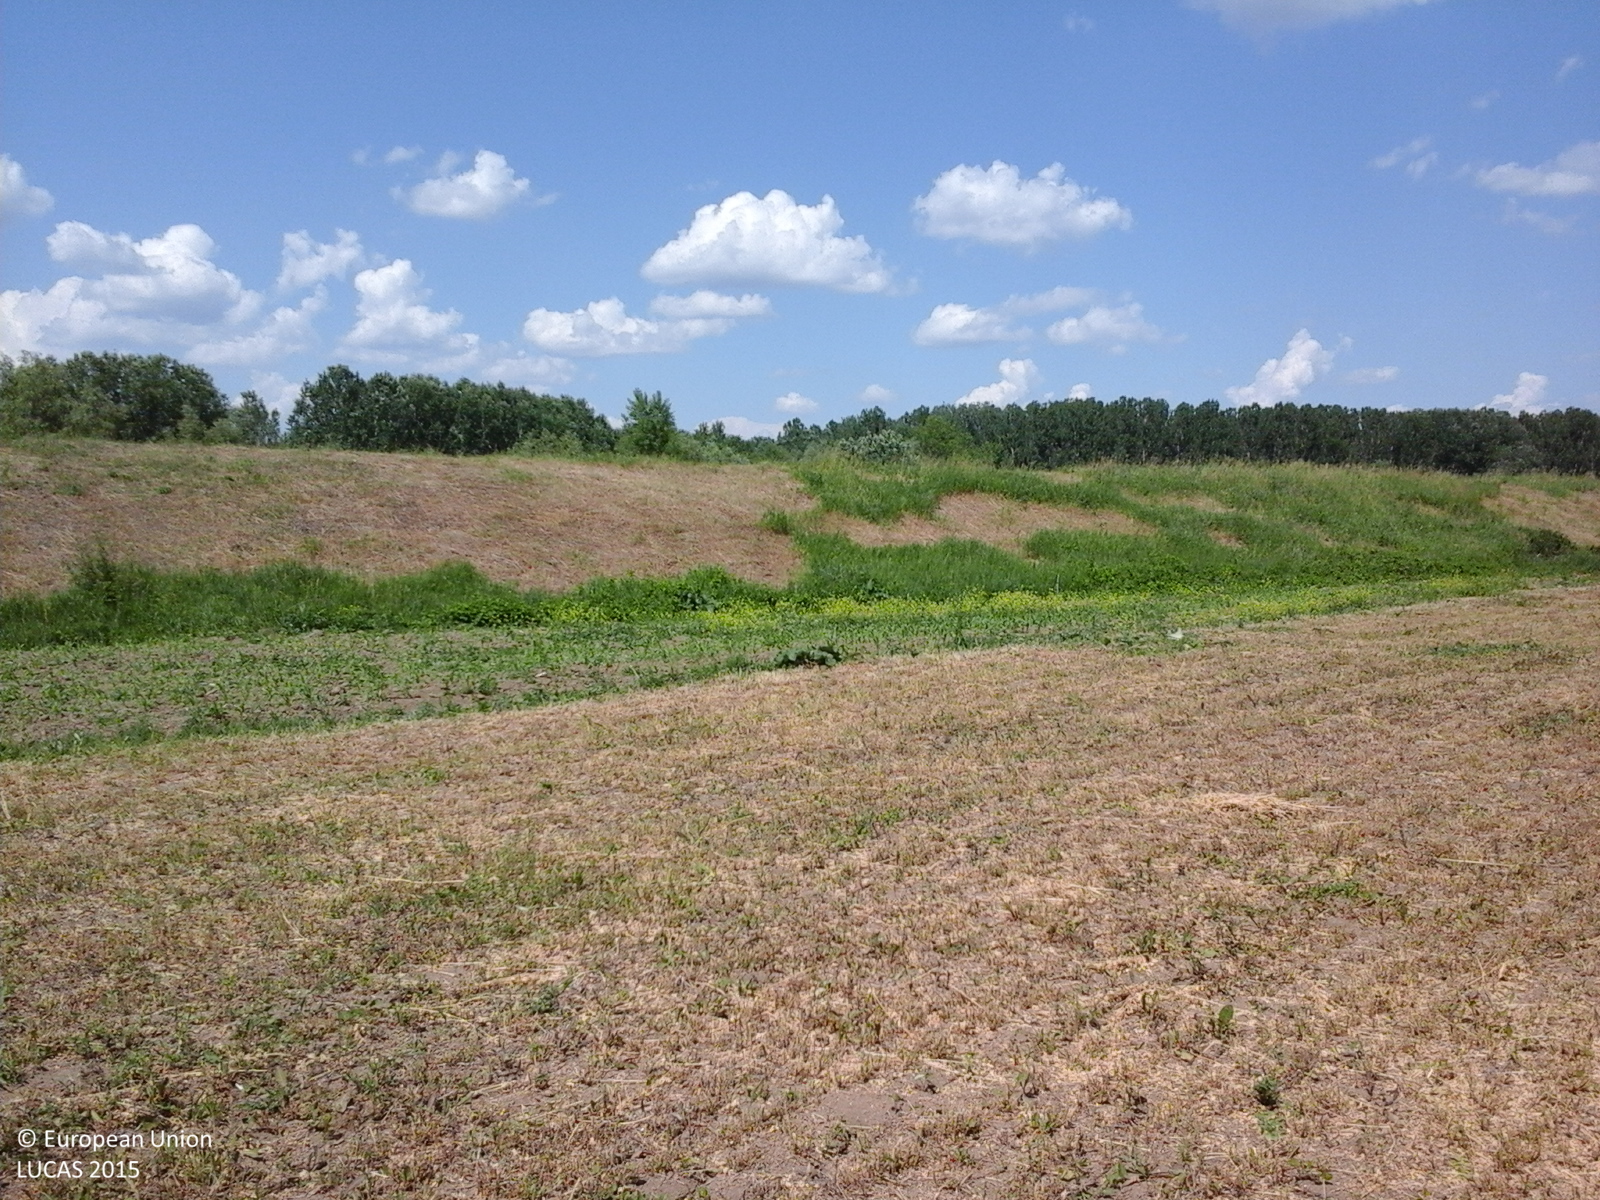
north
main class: Cropland
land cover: Lucerne
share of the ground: 10 - 25 %
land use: Agriculture (excluding fallow land and kitchen gardens)
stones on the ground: < 10 %
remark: Harvested field
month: June
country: RO
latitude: 46.7735
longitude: 26.9241
